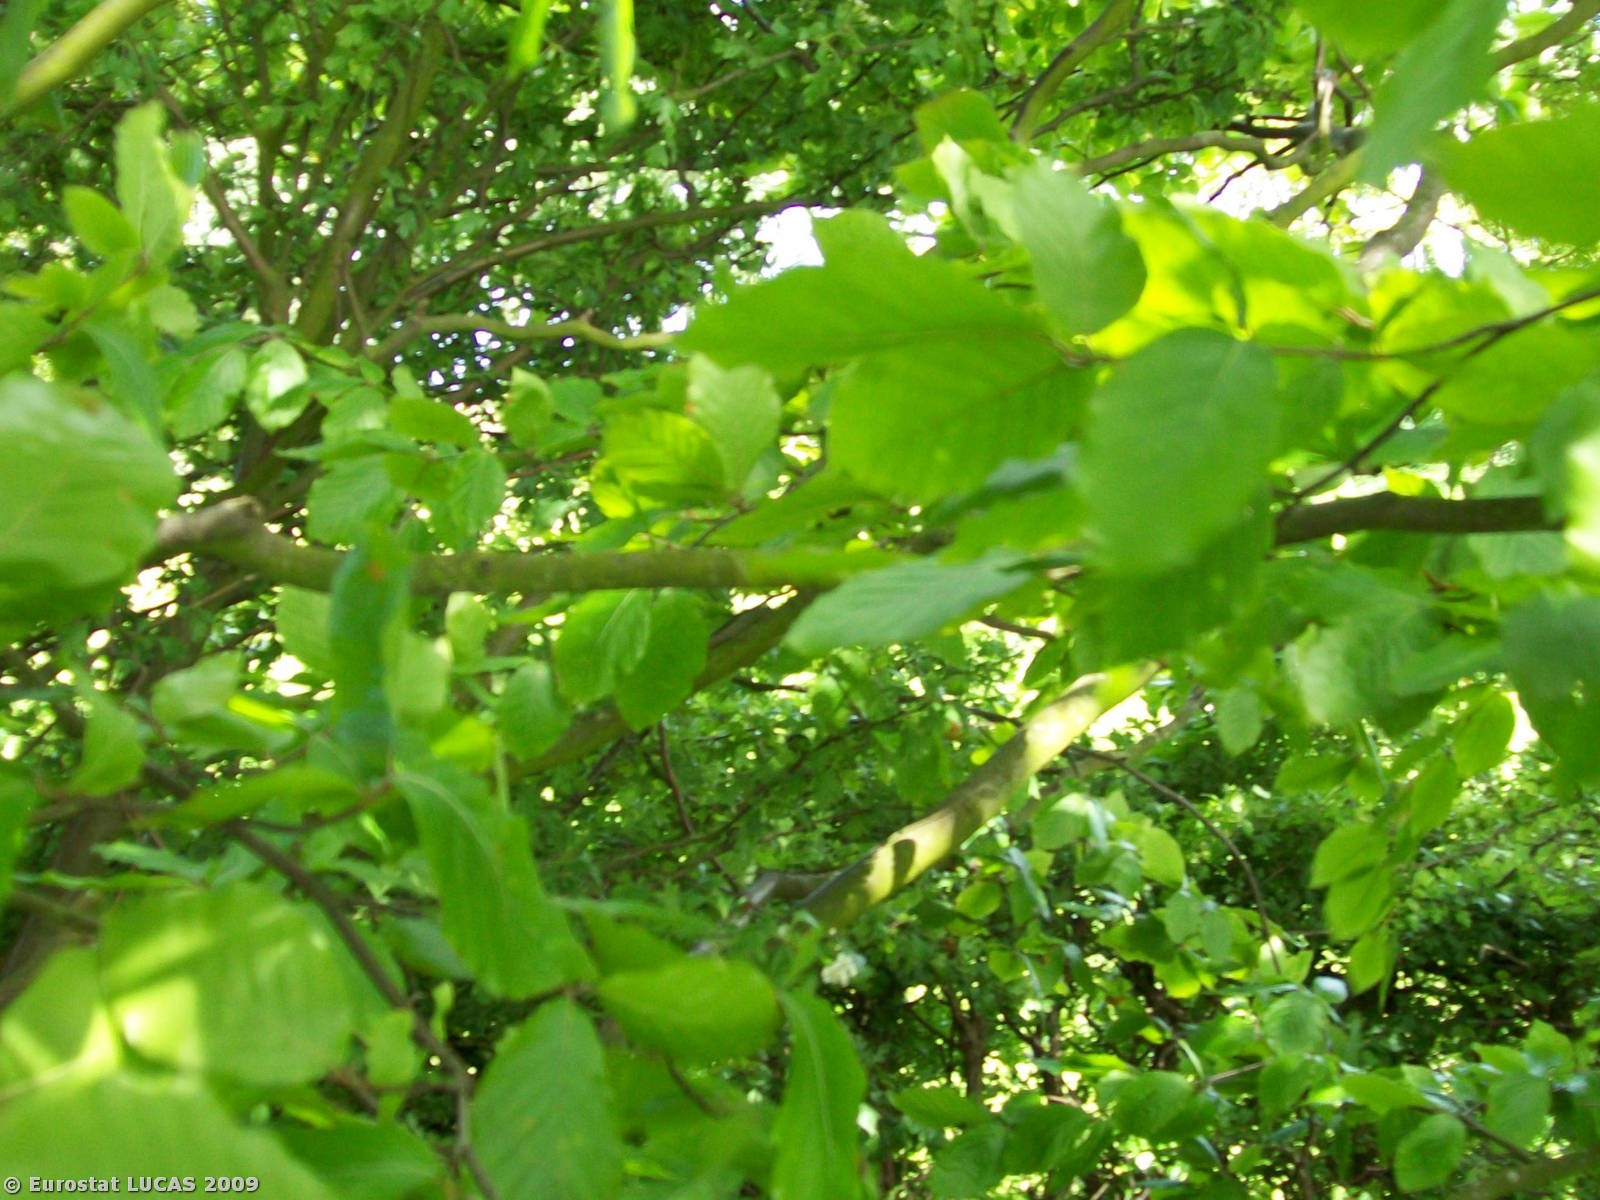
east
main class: Woodland
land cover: Broadleaved woodland
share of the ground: > 75 %
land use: Unused
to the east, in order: Broadleaved woodland; Managed hedges; Grassland without tree/shrub cover; Broadleaved woodland; Grassland without tree/shrub cover; Ditches and canals; Fences; Grassland without tree/shrub cover; Common wheat
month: May
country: GB
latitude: 52.6660
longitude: 1.7169
